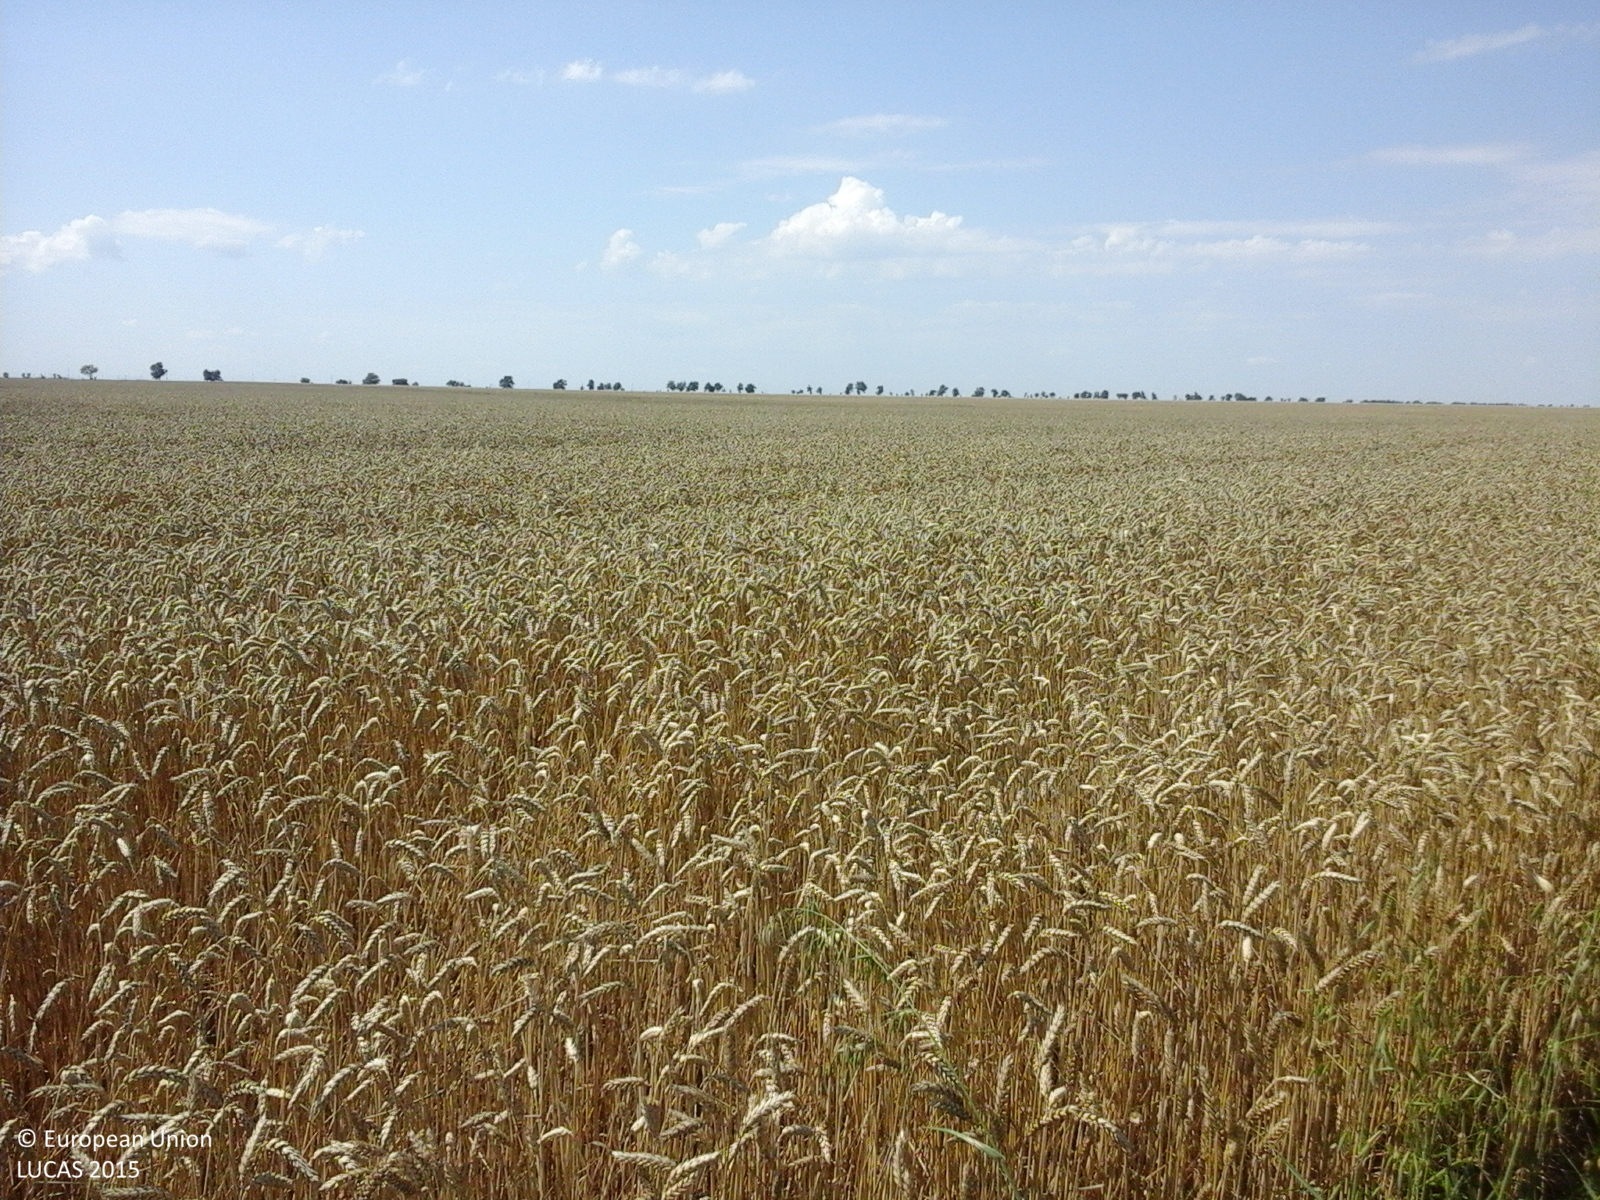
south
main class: Cropland
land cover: Common wheat
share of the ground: > 75 %
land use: Agriculture (excluding fallow land and kitchen gardens)
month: July
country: RO
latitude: 43.9494
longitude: 25.2450
